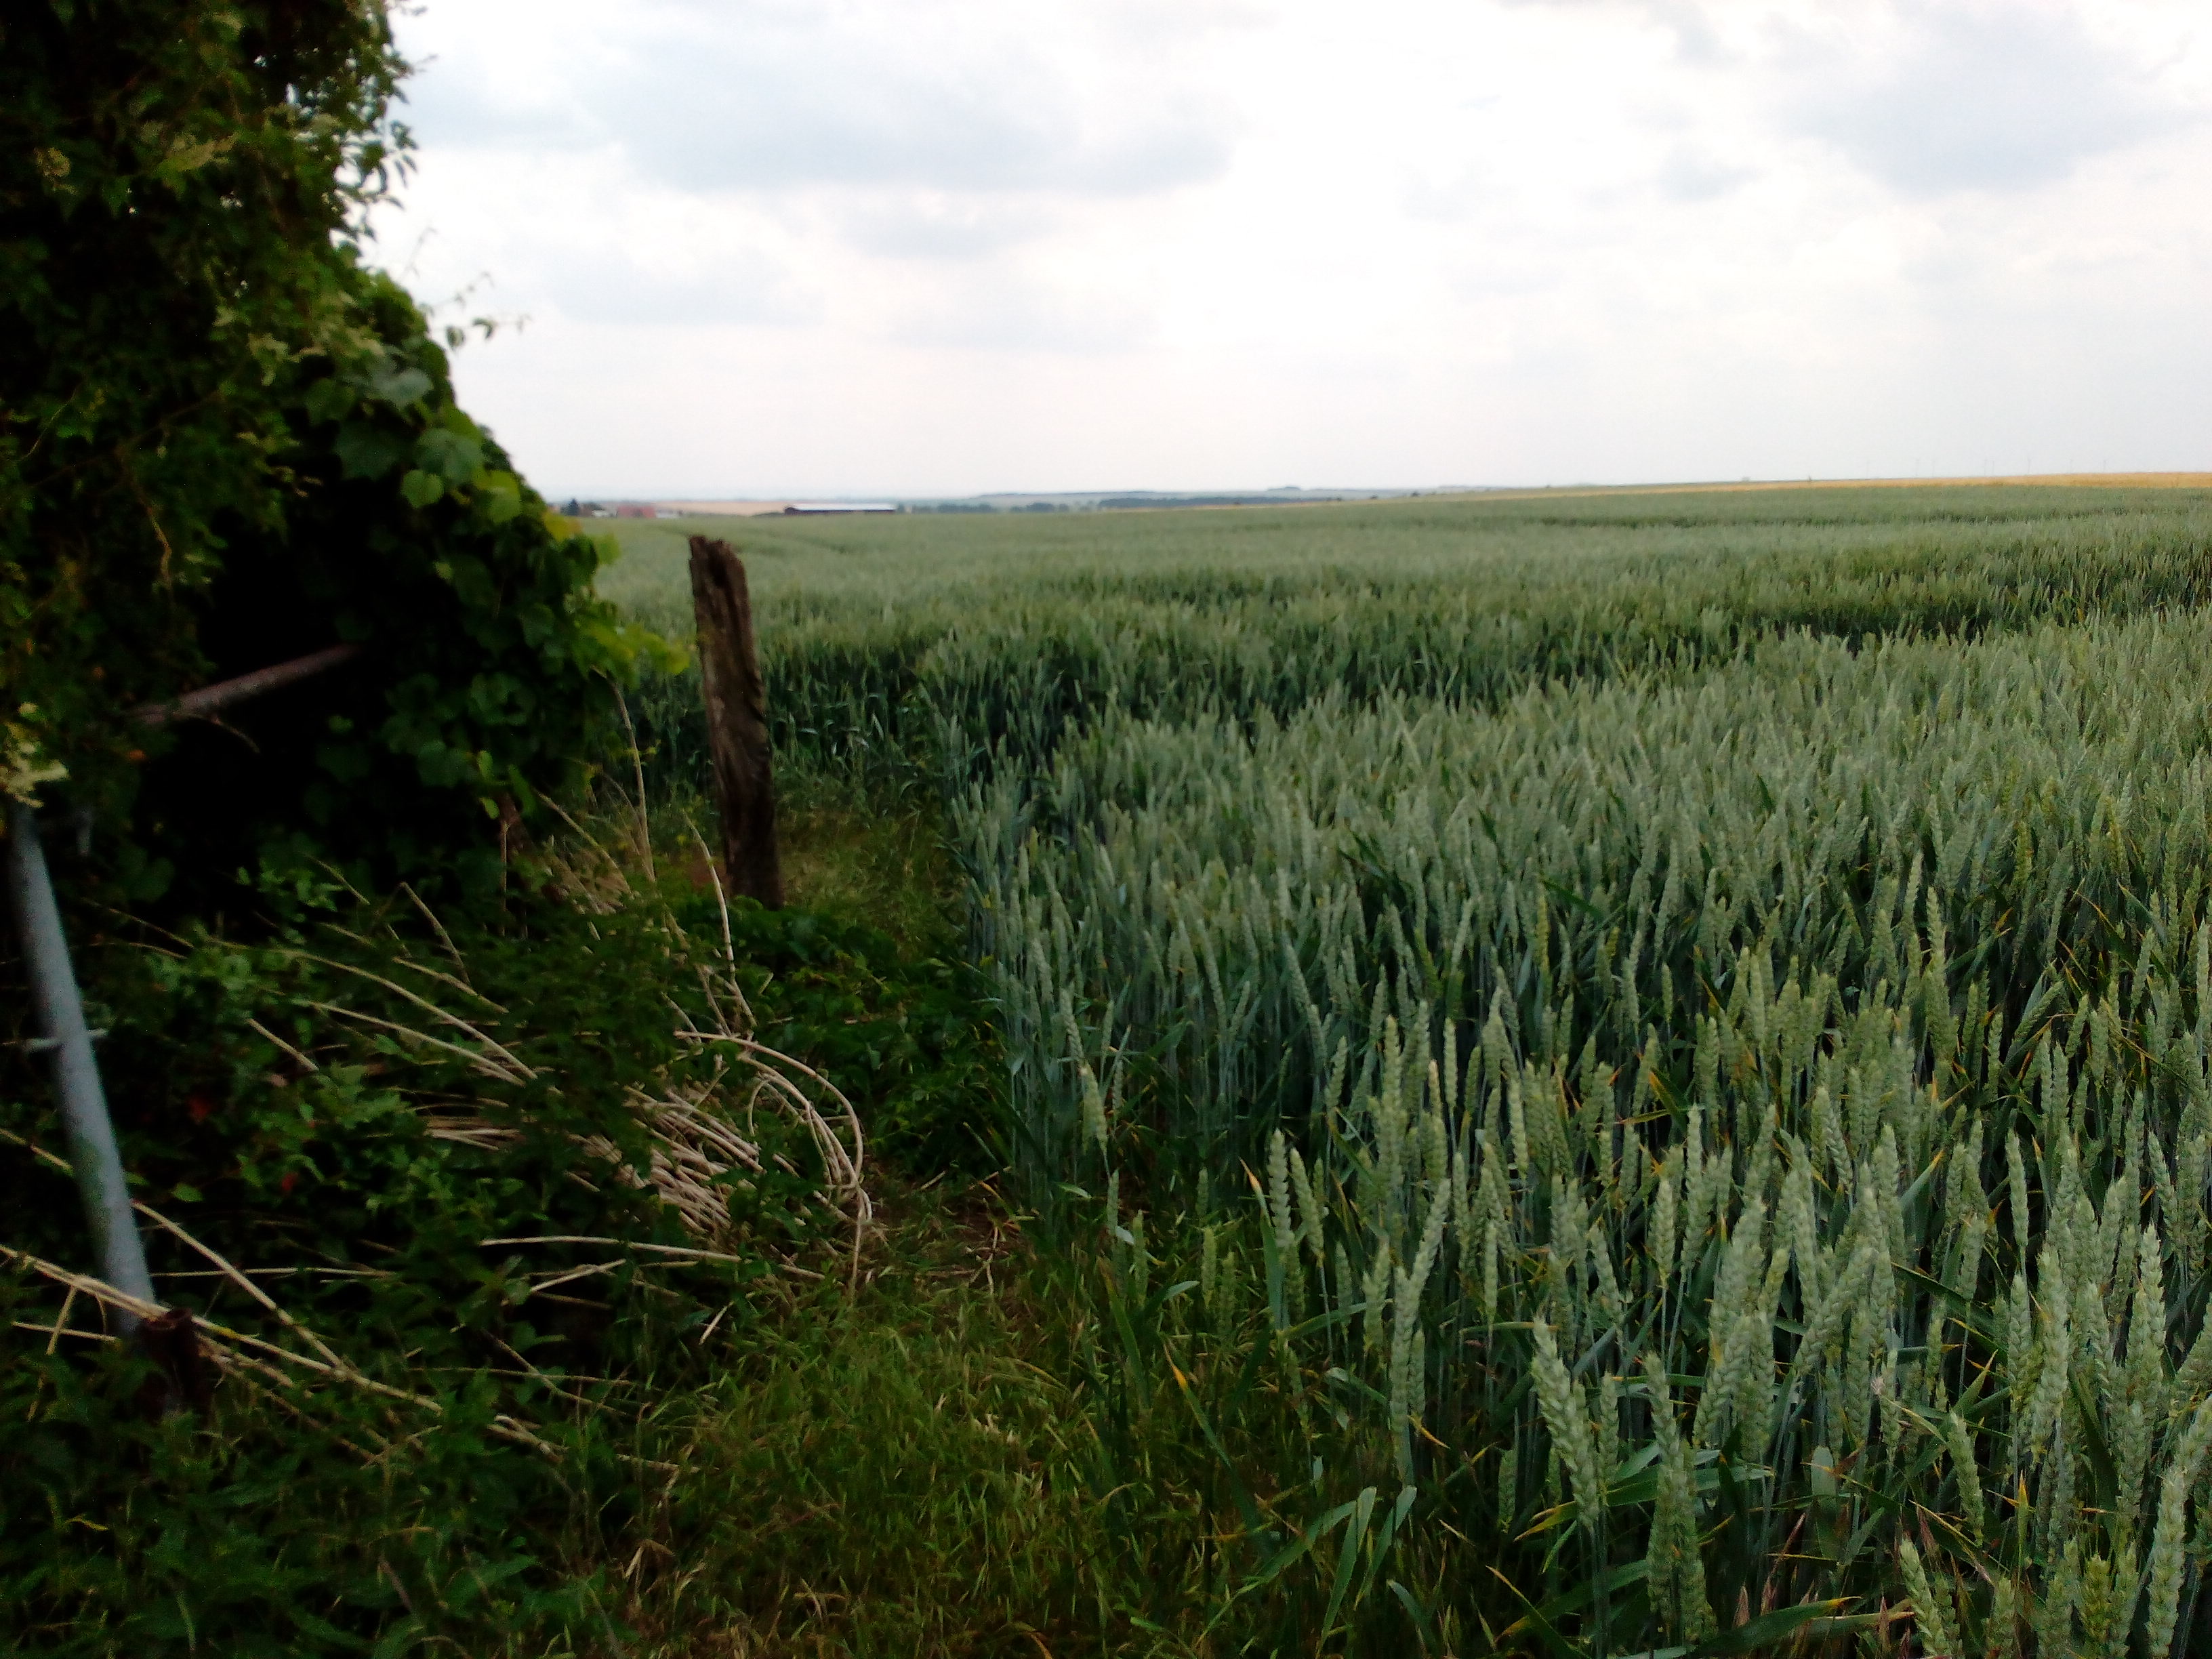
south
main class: Cropland
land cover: Common wheat
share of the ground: > 75 %
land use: Agriculture (excluding fallow land and kitchen gardens)
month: June
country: DE
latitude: 51.2398
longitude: 11.1026
